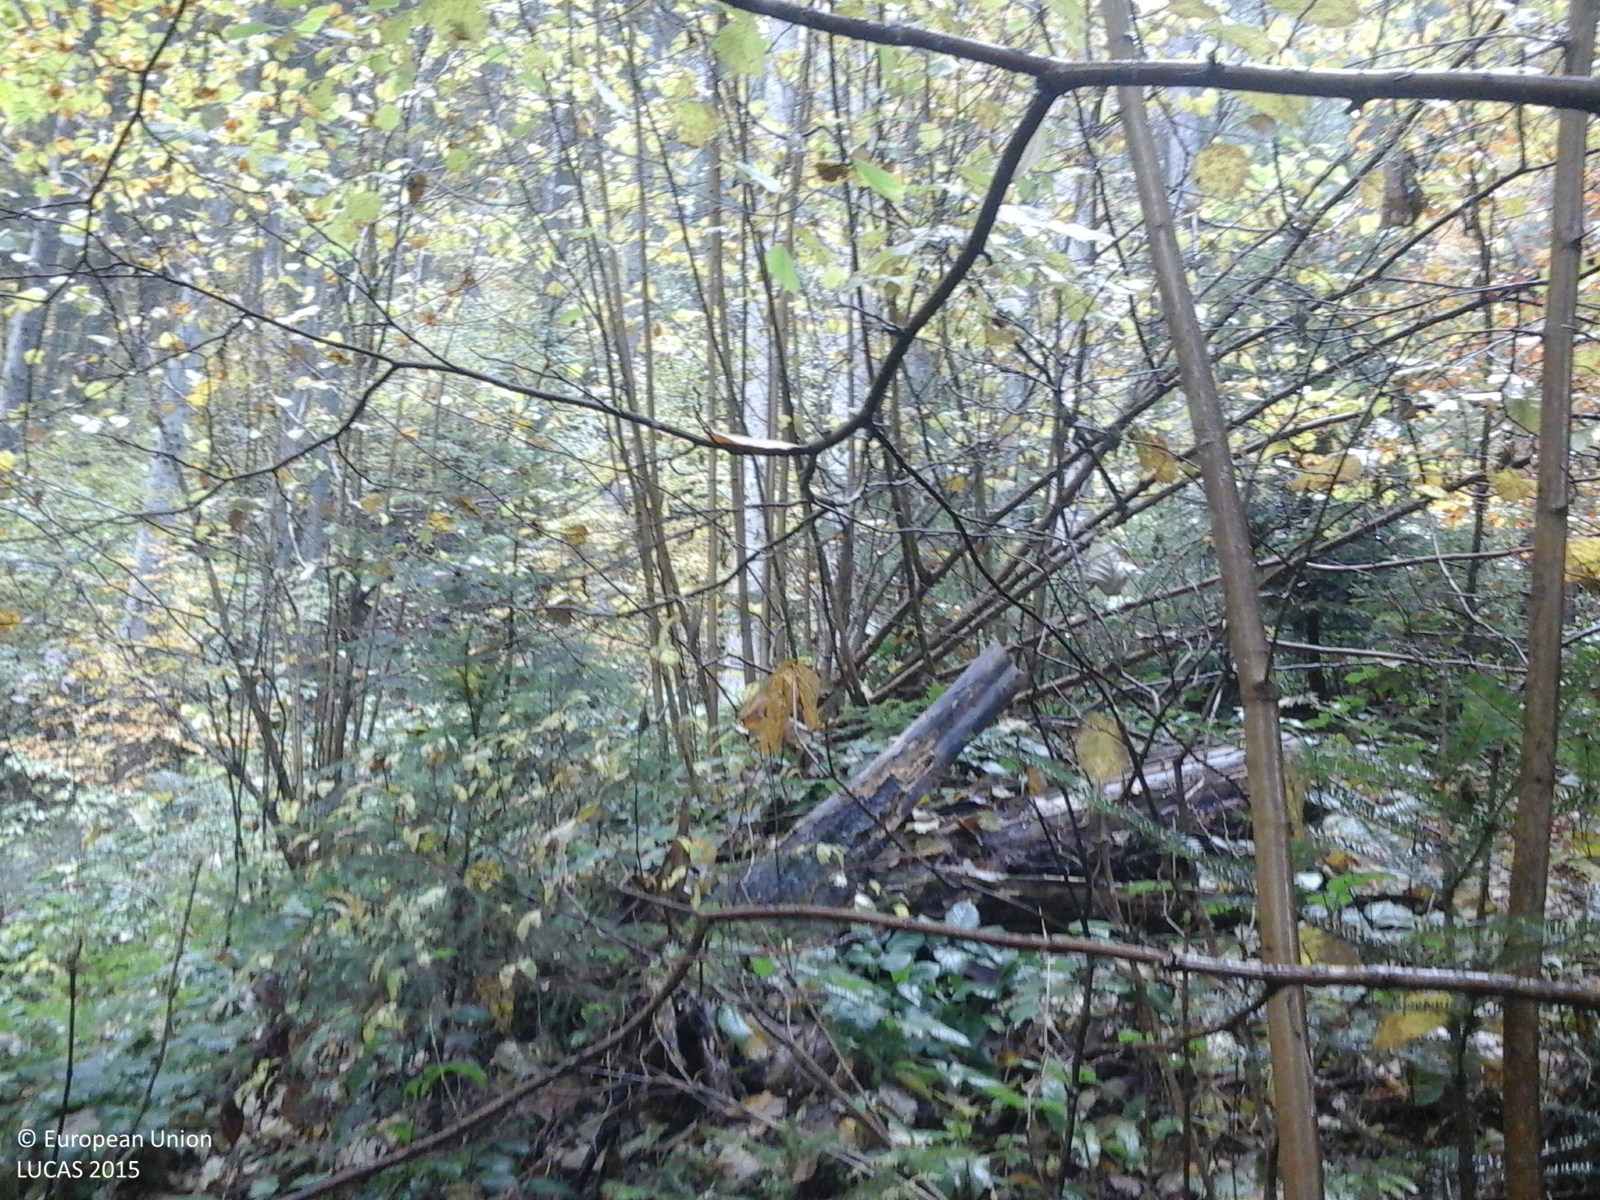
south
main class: Woodland
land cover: Other mixed woodland
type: alpine coniferous forest
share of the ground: > 75 %
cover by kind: coniferous forest trees 70 %, broadleaved forest trees 30 %
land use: Forestry
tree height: > 5 m
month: October
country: RO
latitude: 46.8789
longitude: 25.1272
